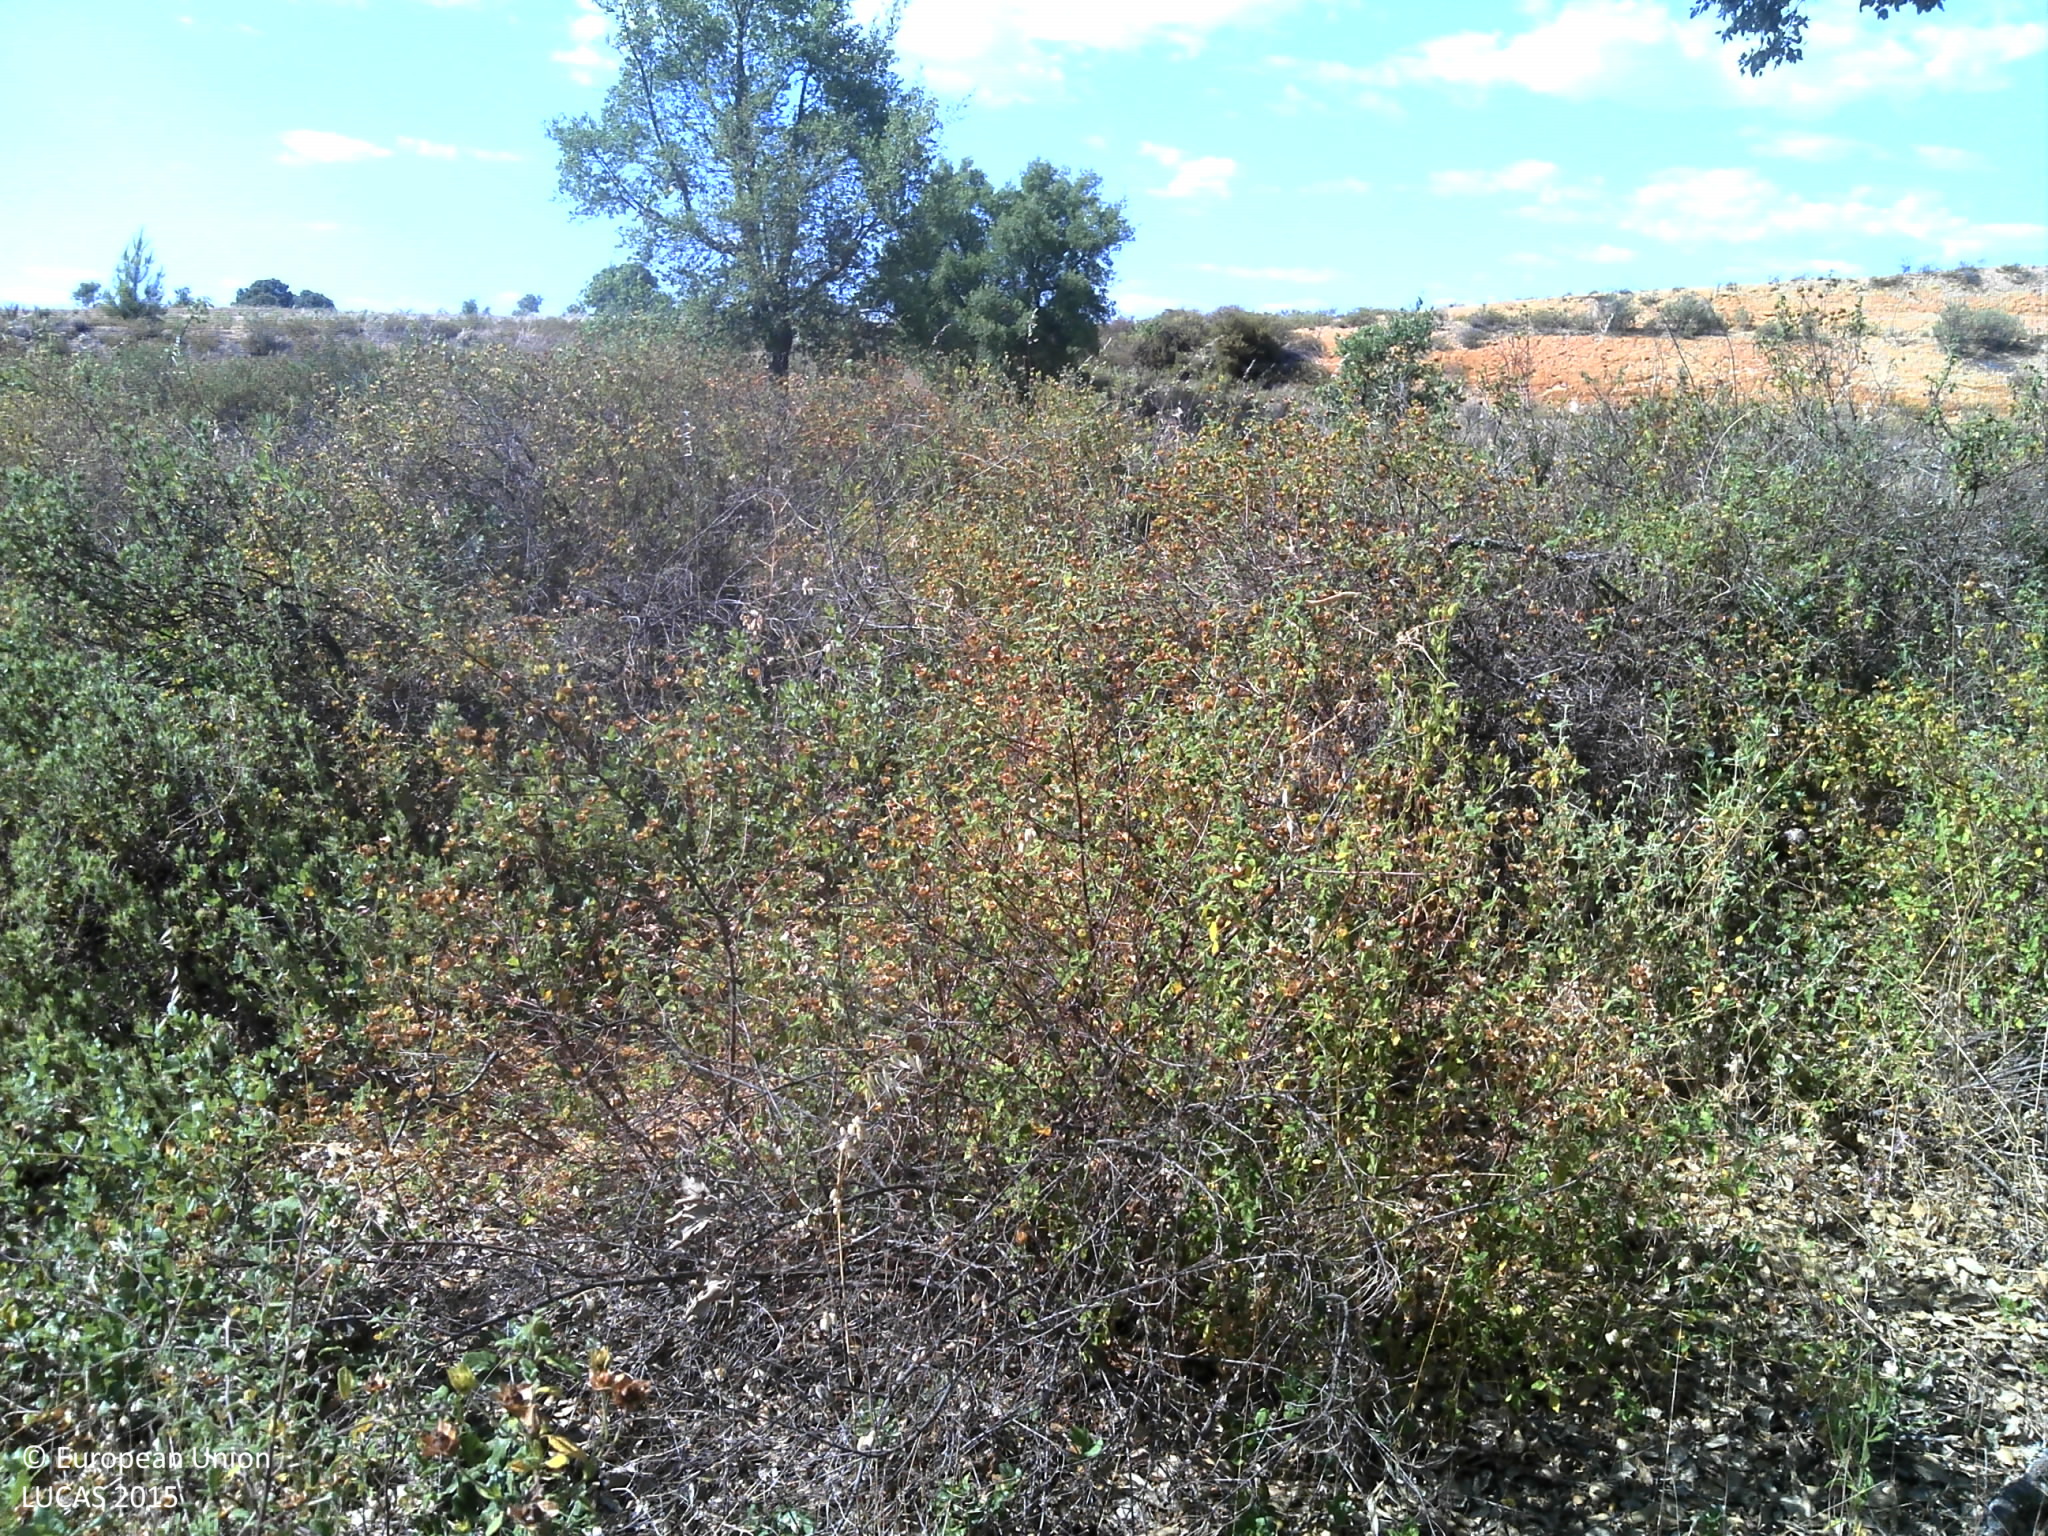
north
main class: Woodland
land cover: Broadleaved woodland
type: broadleaved evergreen forest
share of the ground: 25 - 50 %
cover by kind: shrubs 50 %, broadleaved forest trees 40 %, consolidated bare surface 10 %
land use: Forestry
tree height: > 5 m
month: May
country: PT
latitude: 38.0123
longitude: -8.3895
